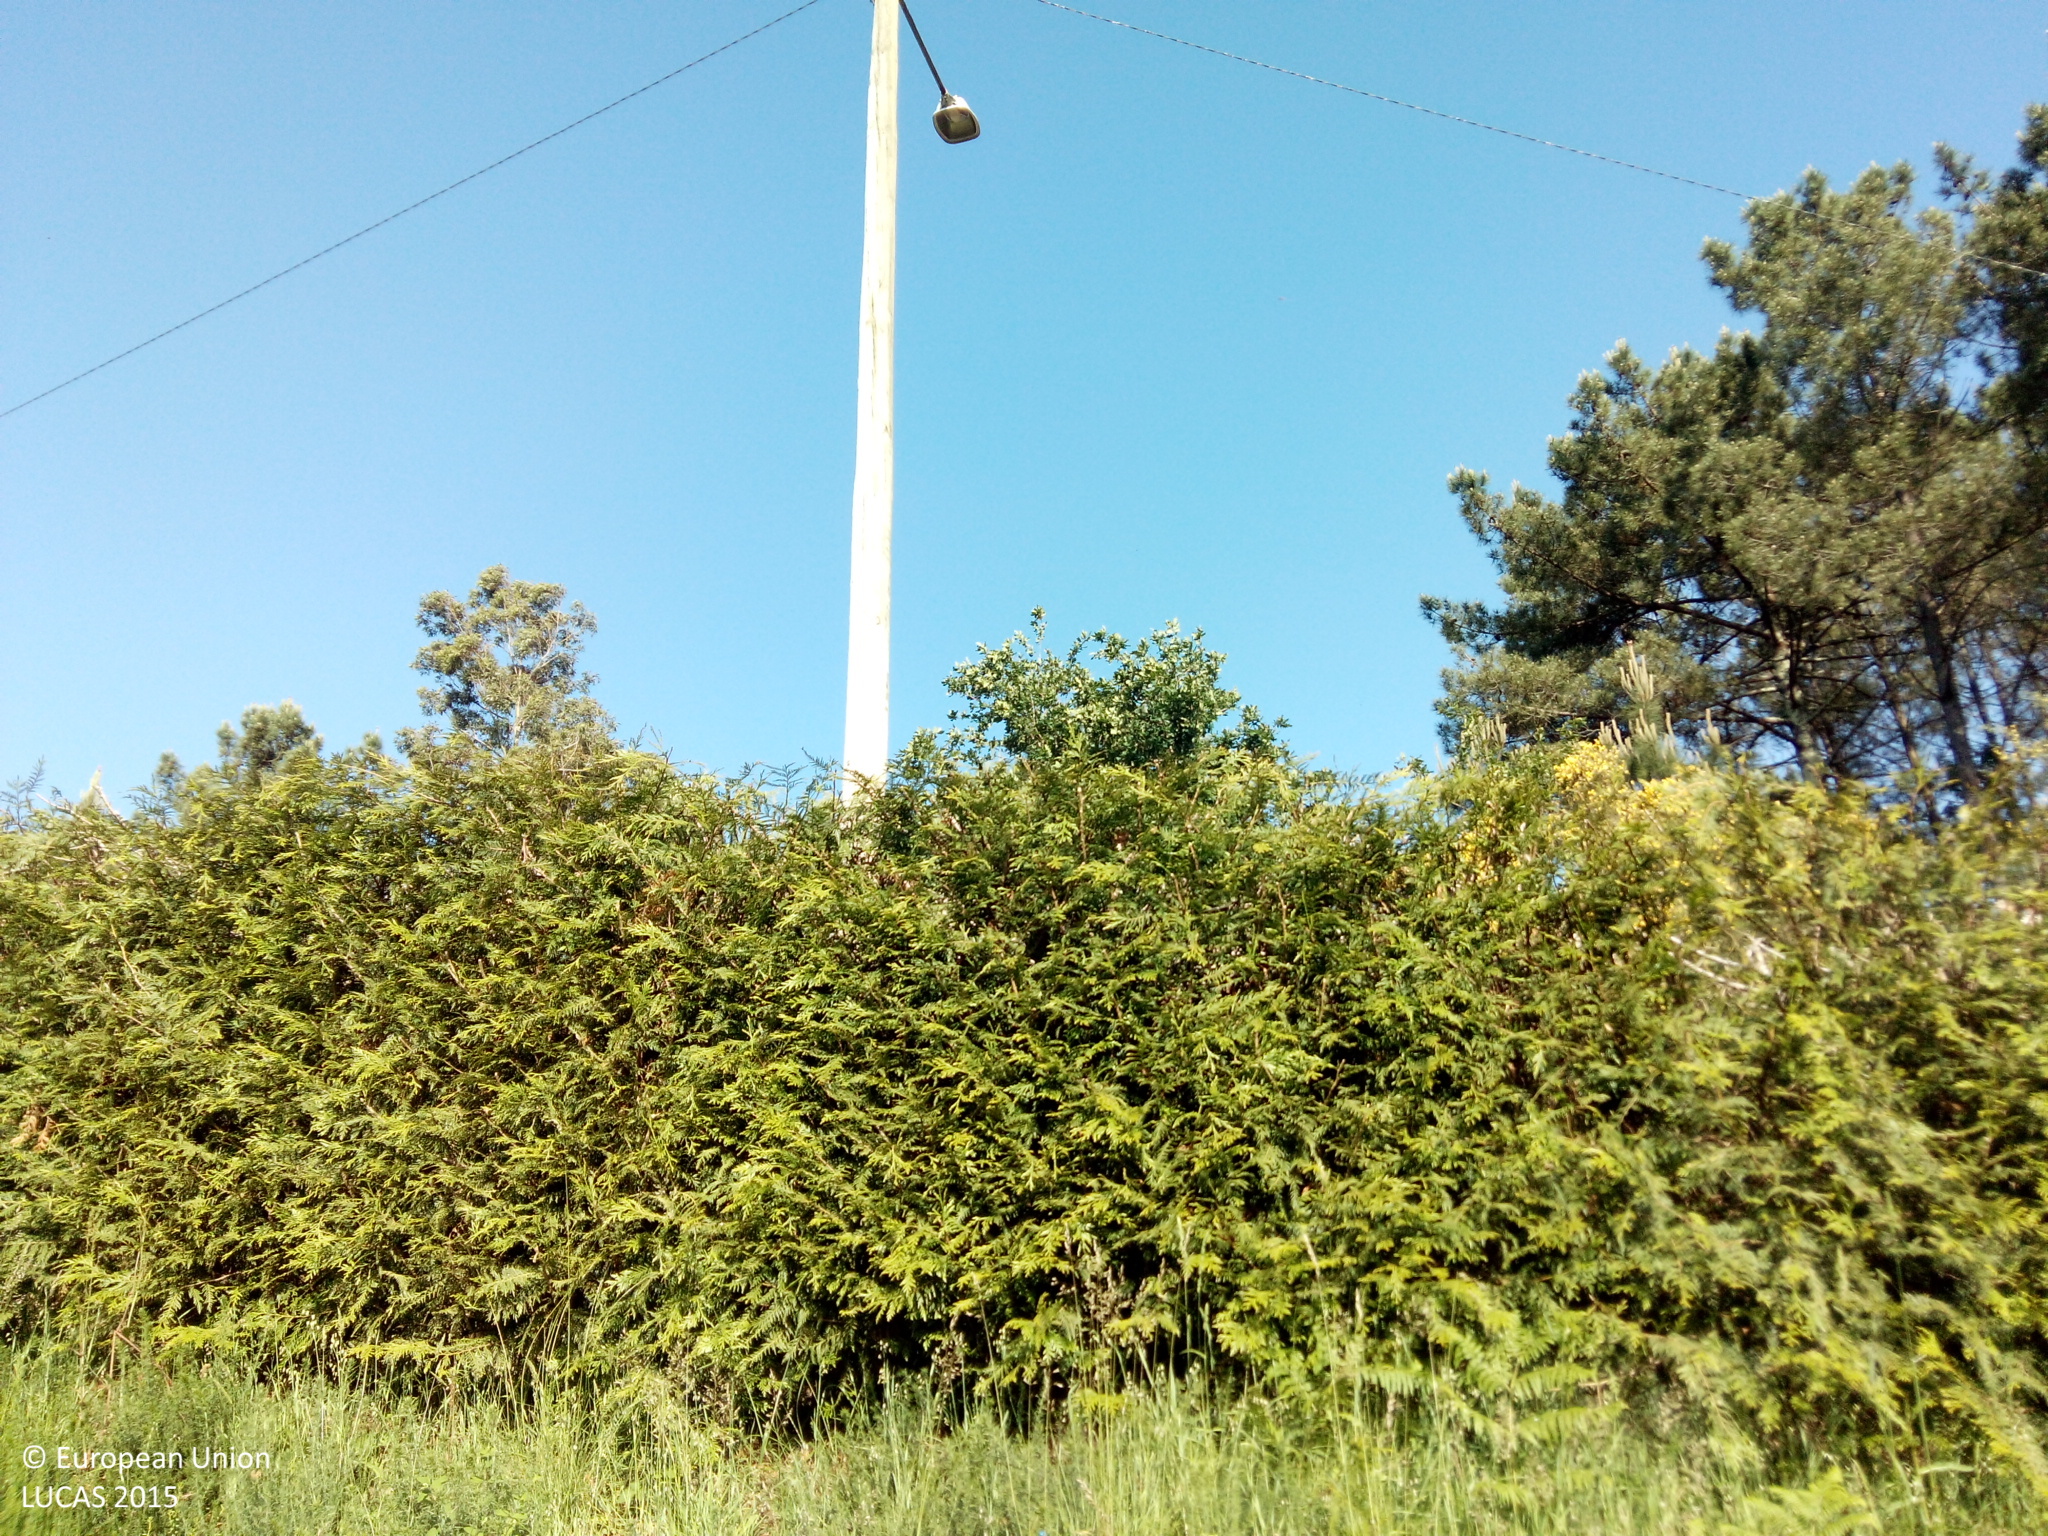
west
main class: Grassland
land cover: Grassland without tree/shrub cover
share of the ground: > 75 %
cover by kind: herbaceous plants 100 %
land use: Abandoned areas
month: May
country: ES
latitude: 42.6930
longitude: -8.4702
